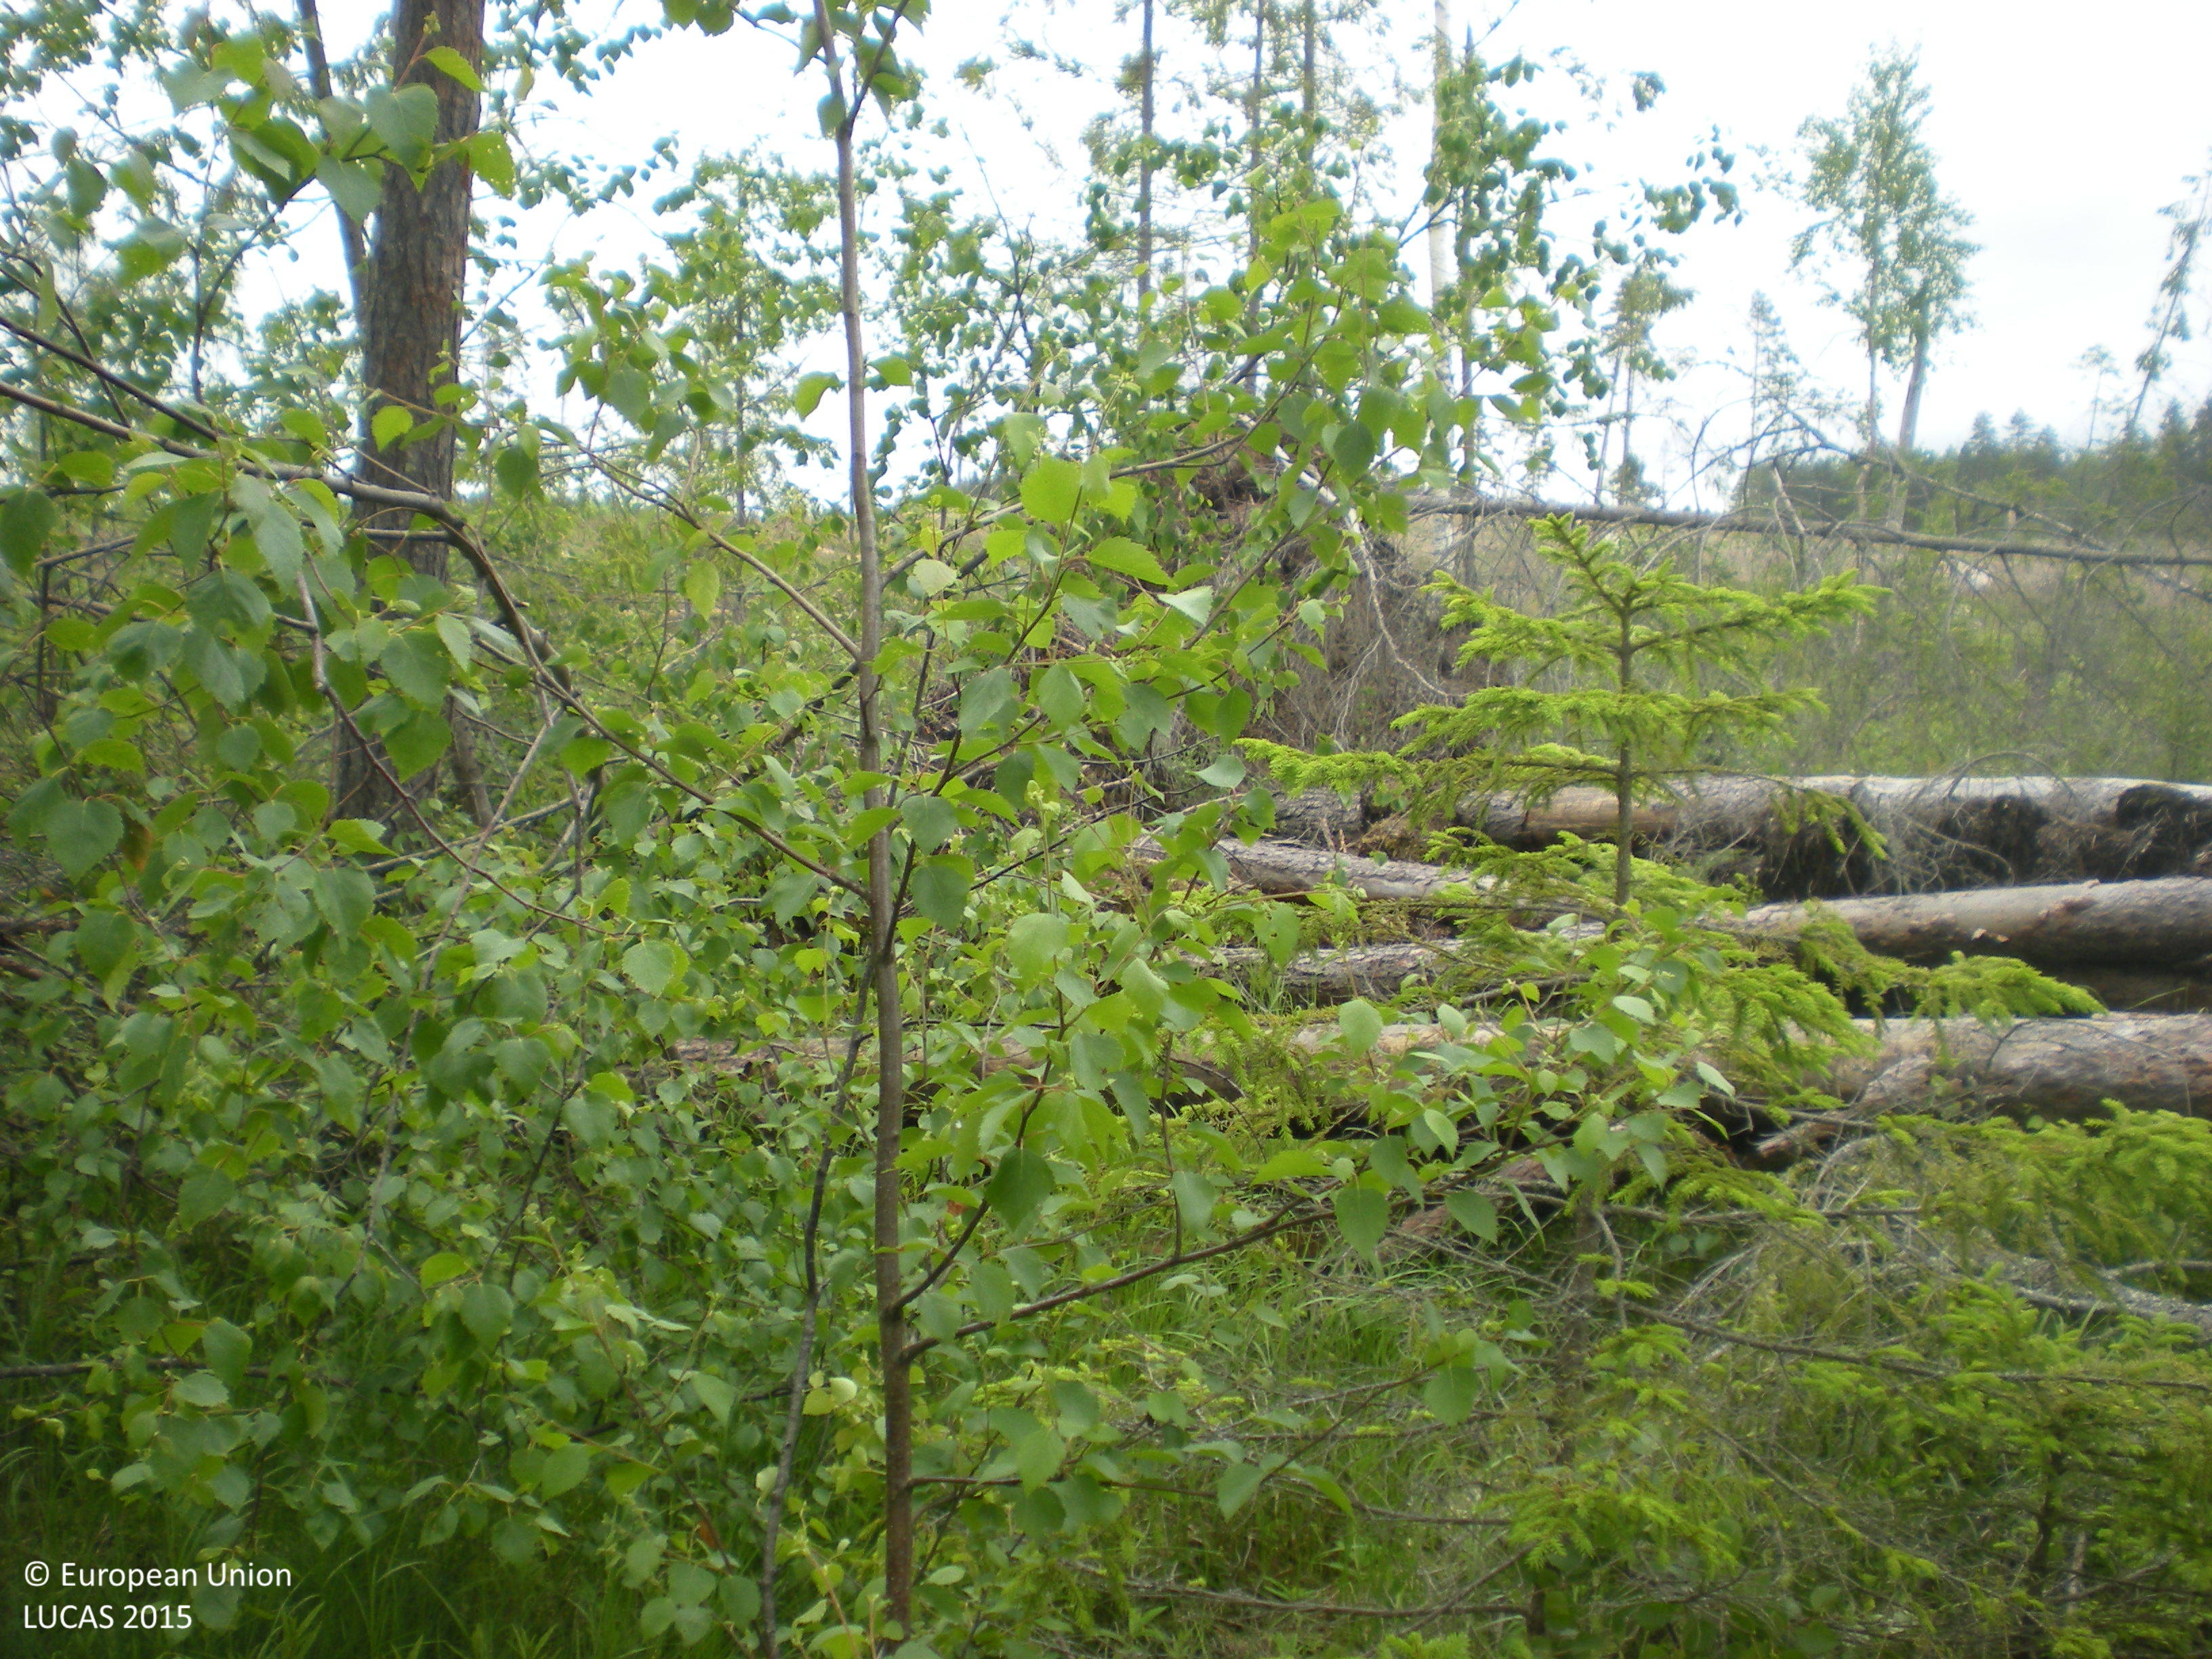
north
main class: Woodland
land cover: Other coniferous woodland
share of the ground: 50 - 75 %
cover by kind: coniferous forest trees 45 %, broadleaved forest trees 15 %, shrubs 15 %, lichens and mosses 15 %, herbaceous plants 5 %
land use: Forestry
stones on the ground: < 10 %
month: June
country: SE
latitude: 60.3824
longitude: 17.7744
